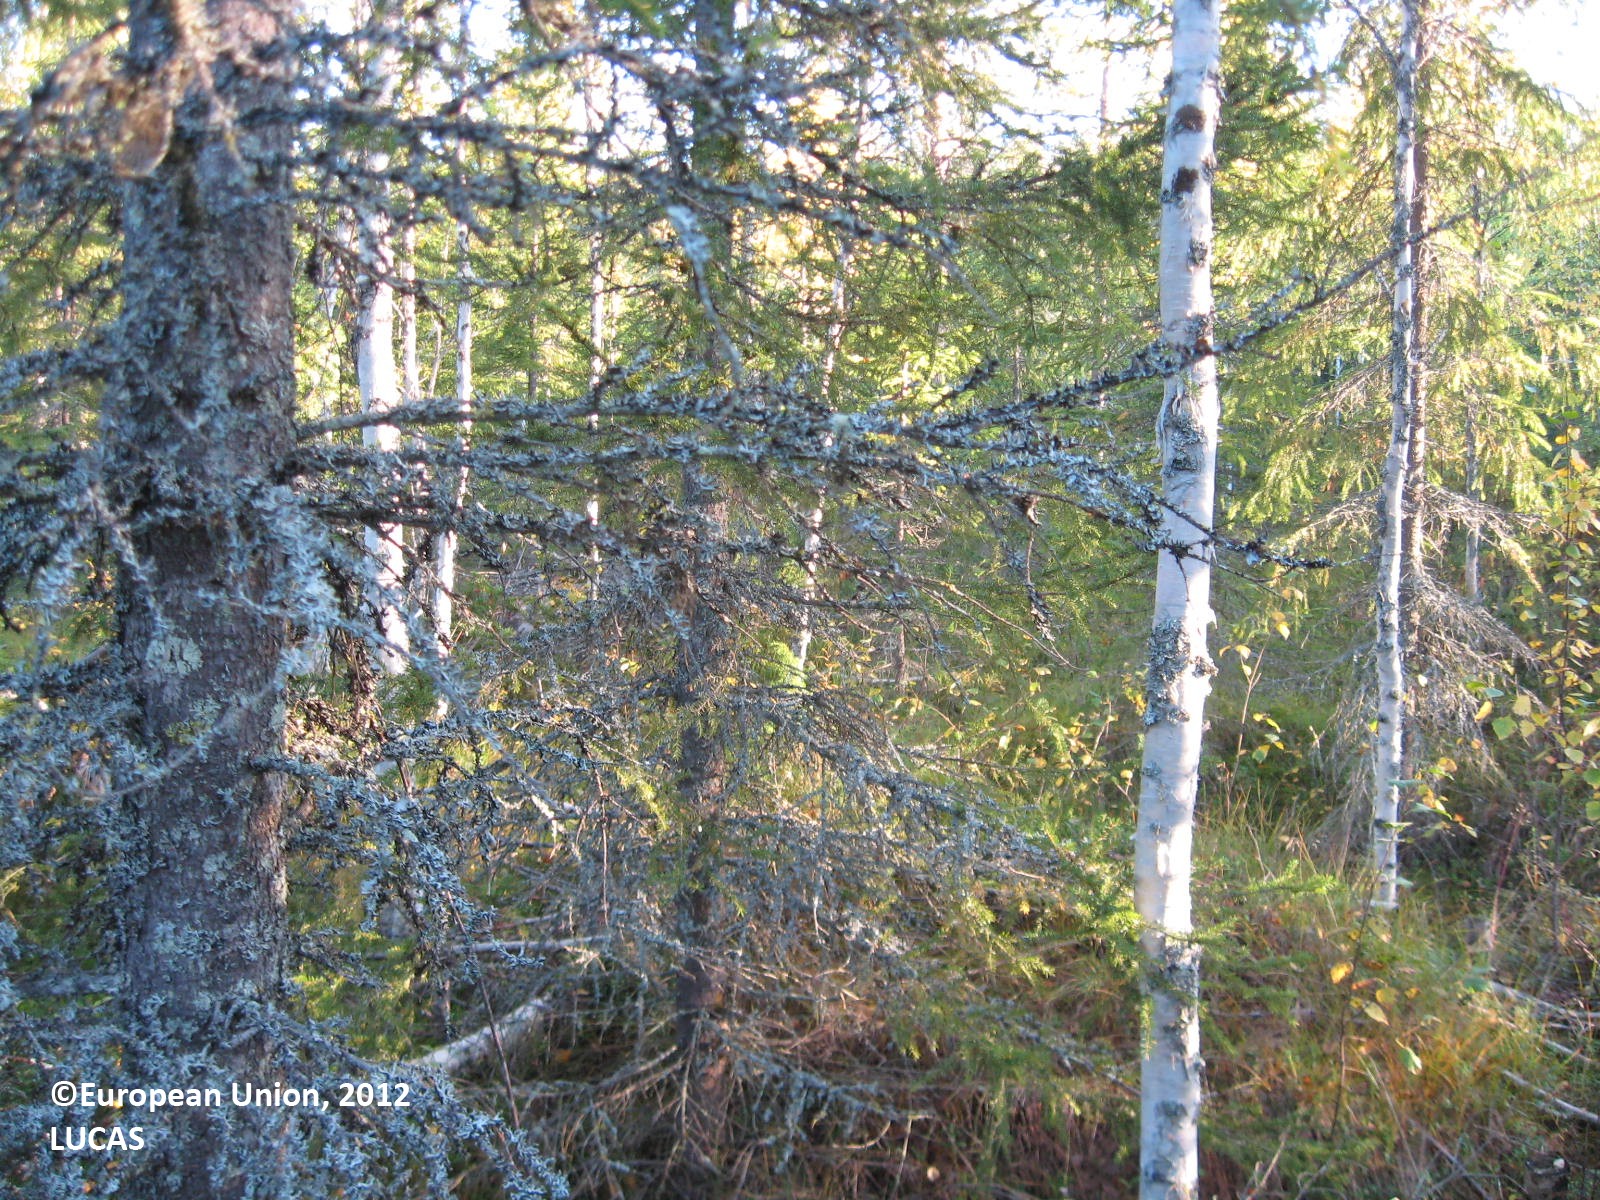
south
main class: Woodland
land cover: Spruce dominated mixed woodland
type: boreal forest
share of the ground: > 75 %
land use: Forestry
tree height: > 5 m
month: August
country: FI
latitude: 63.8567
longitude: 29.8248
